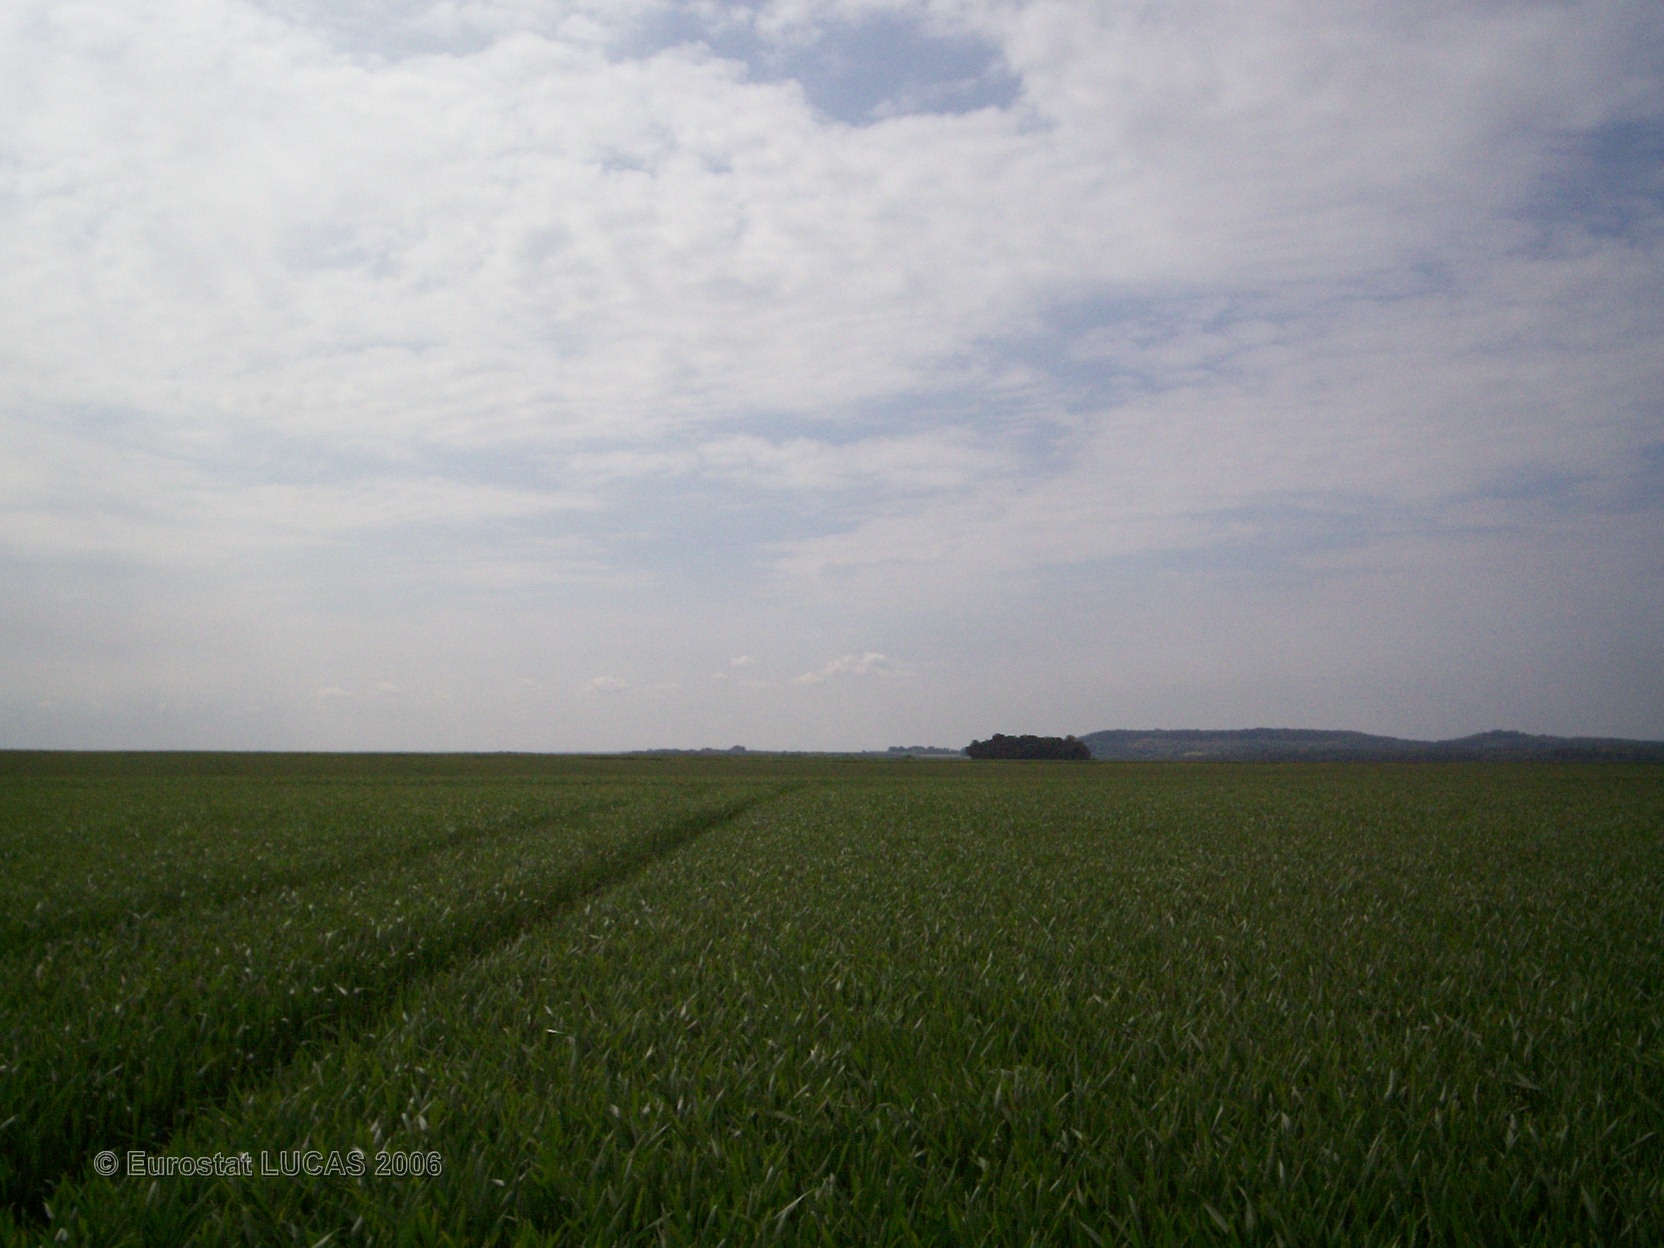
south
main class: Cropland
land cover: Common wheat
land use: Agriculture (excluding fallow land and kitchen gardens)
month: June
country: FR
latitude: 49.4476
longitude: 2.7479
